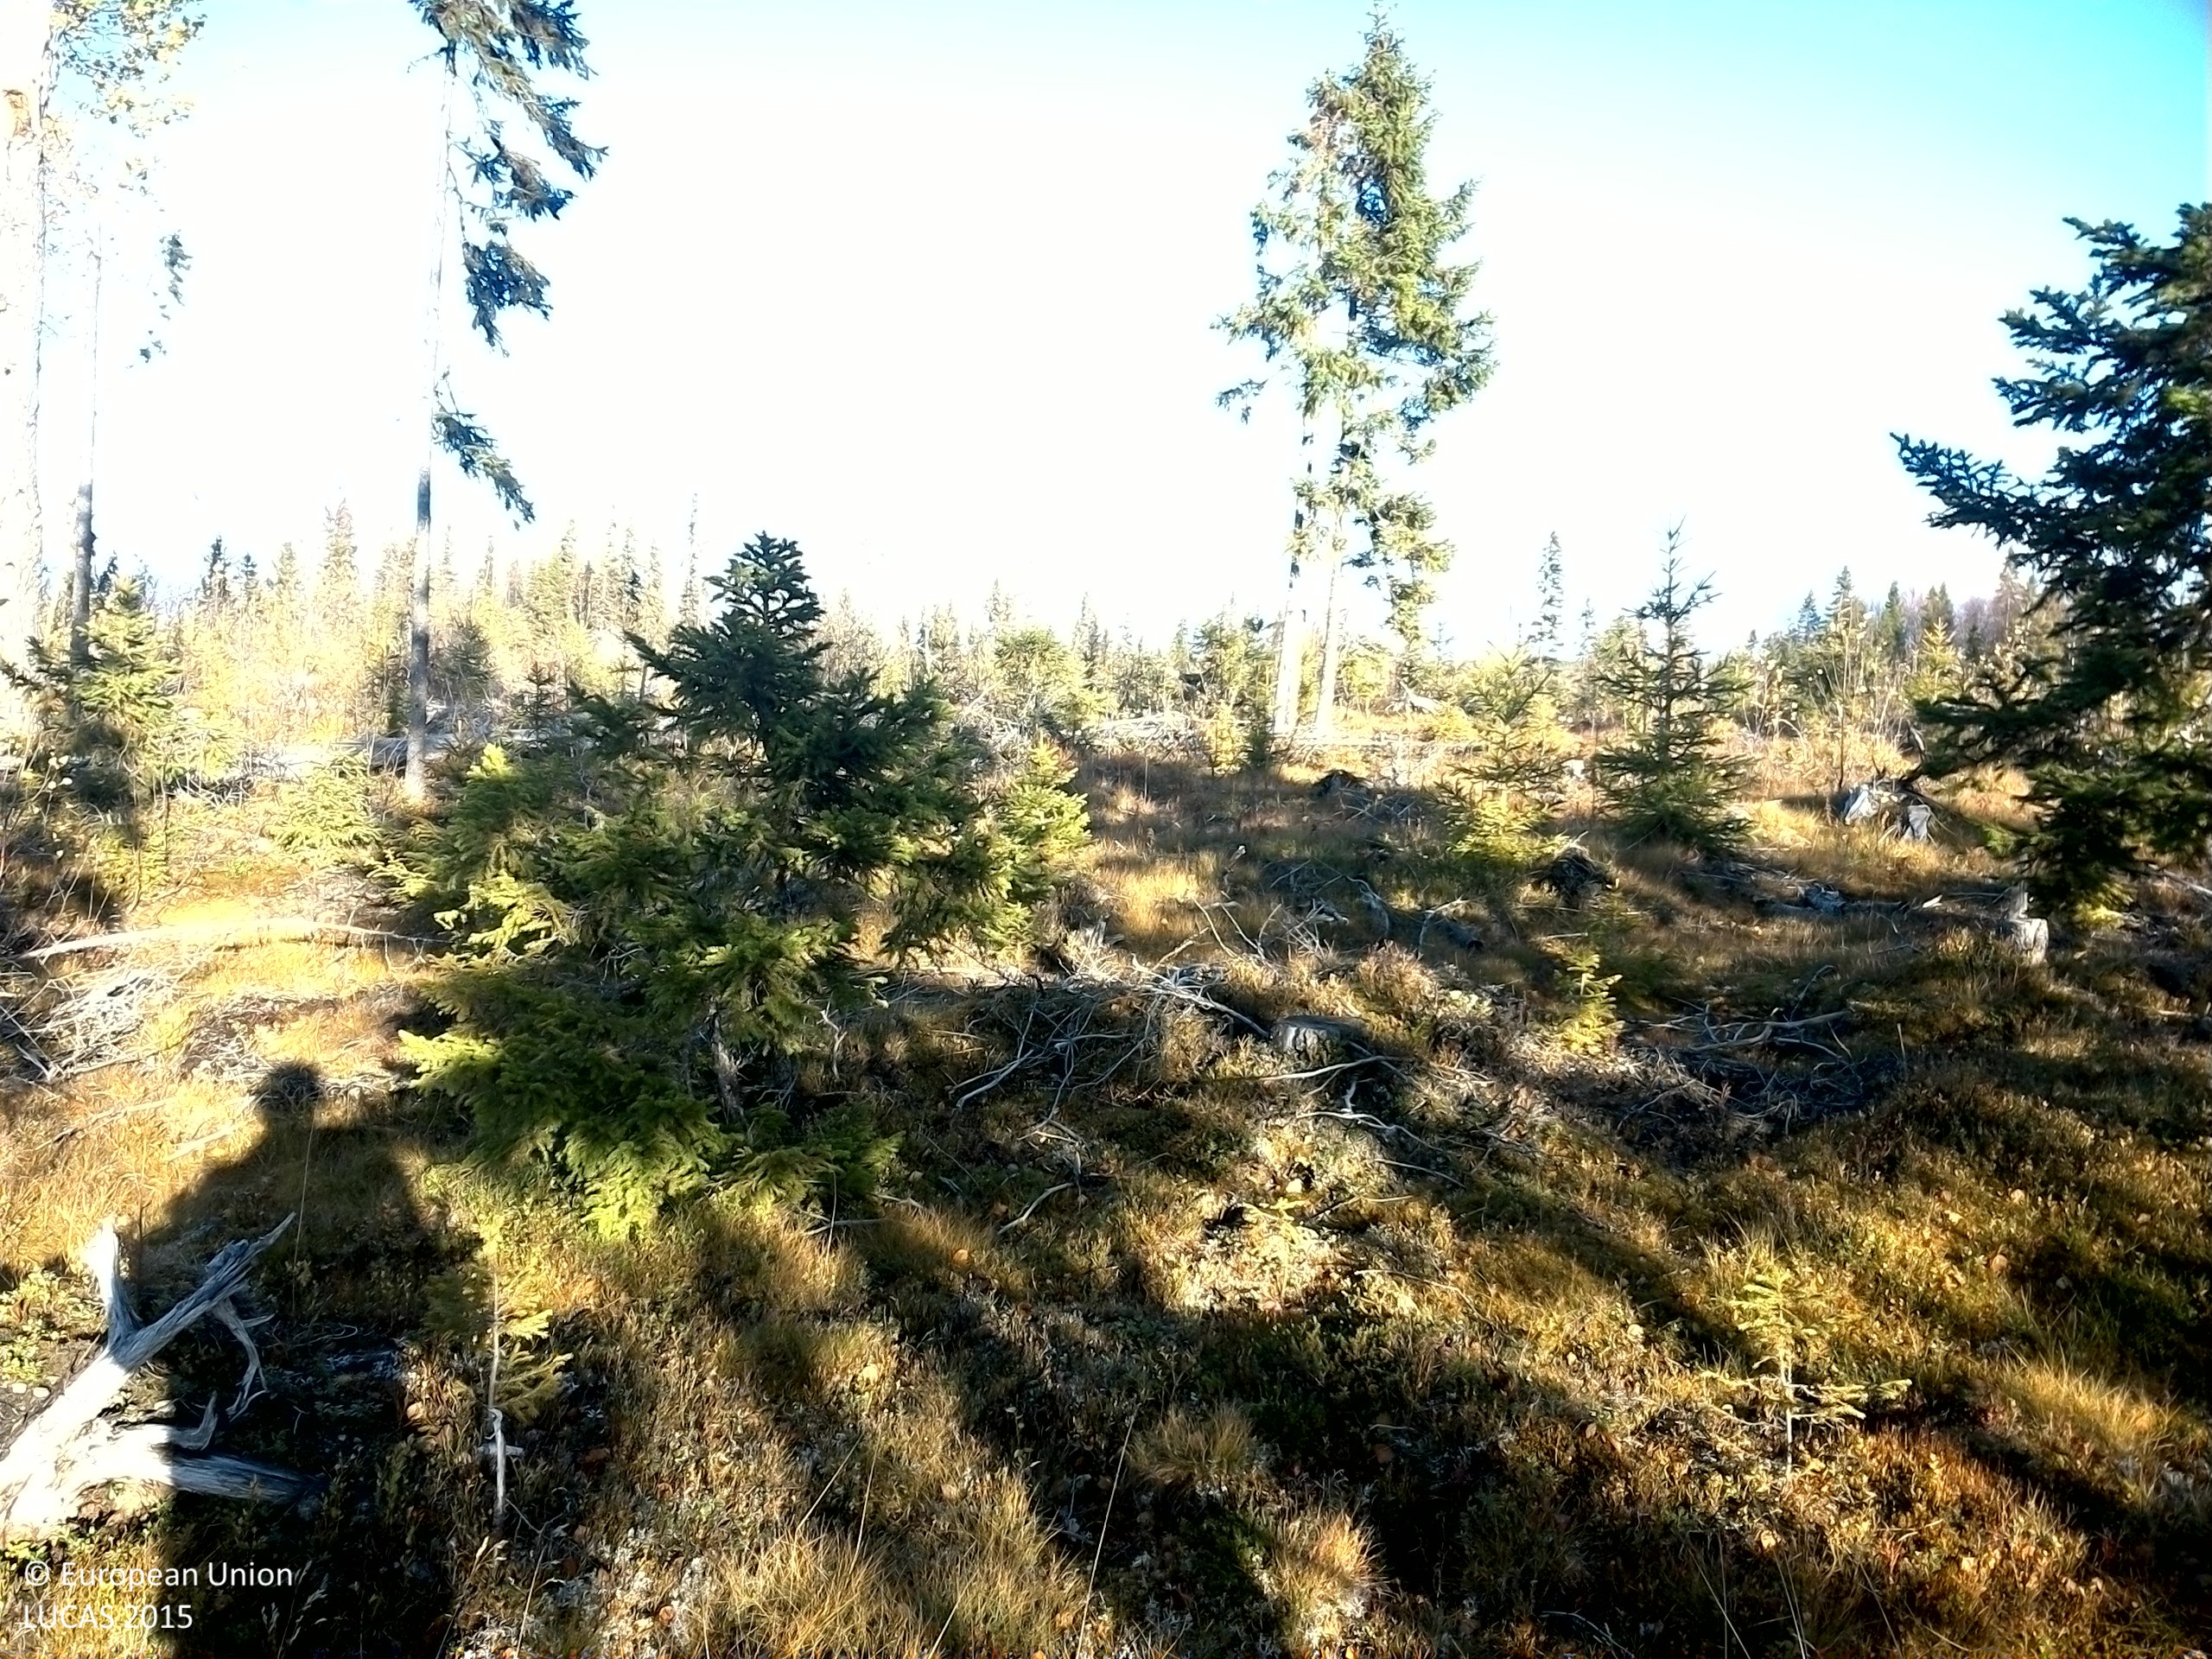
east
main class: Woodland
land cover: Spruce dominated mixed woodland
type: boreal forest
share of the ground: 25 - 50 %
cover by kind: shrubs 45 %, coniferous forest trees 25 %, broadleaved forest trees 15 %, lichens and mosses 15 %
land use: Forestry
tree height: > 5 m
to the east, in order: Spruce dominated mixed woodland
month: October
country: SE
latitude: 64.1909
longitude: 16.0845
